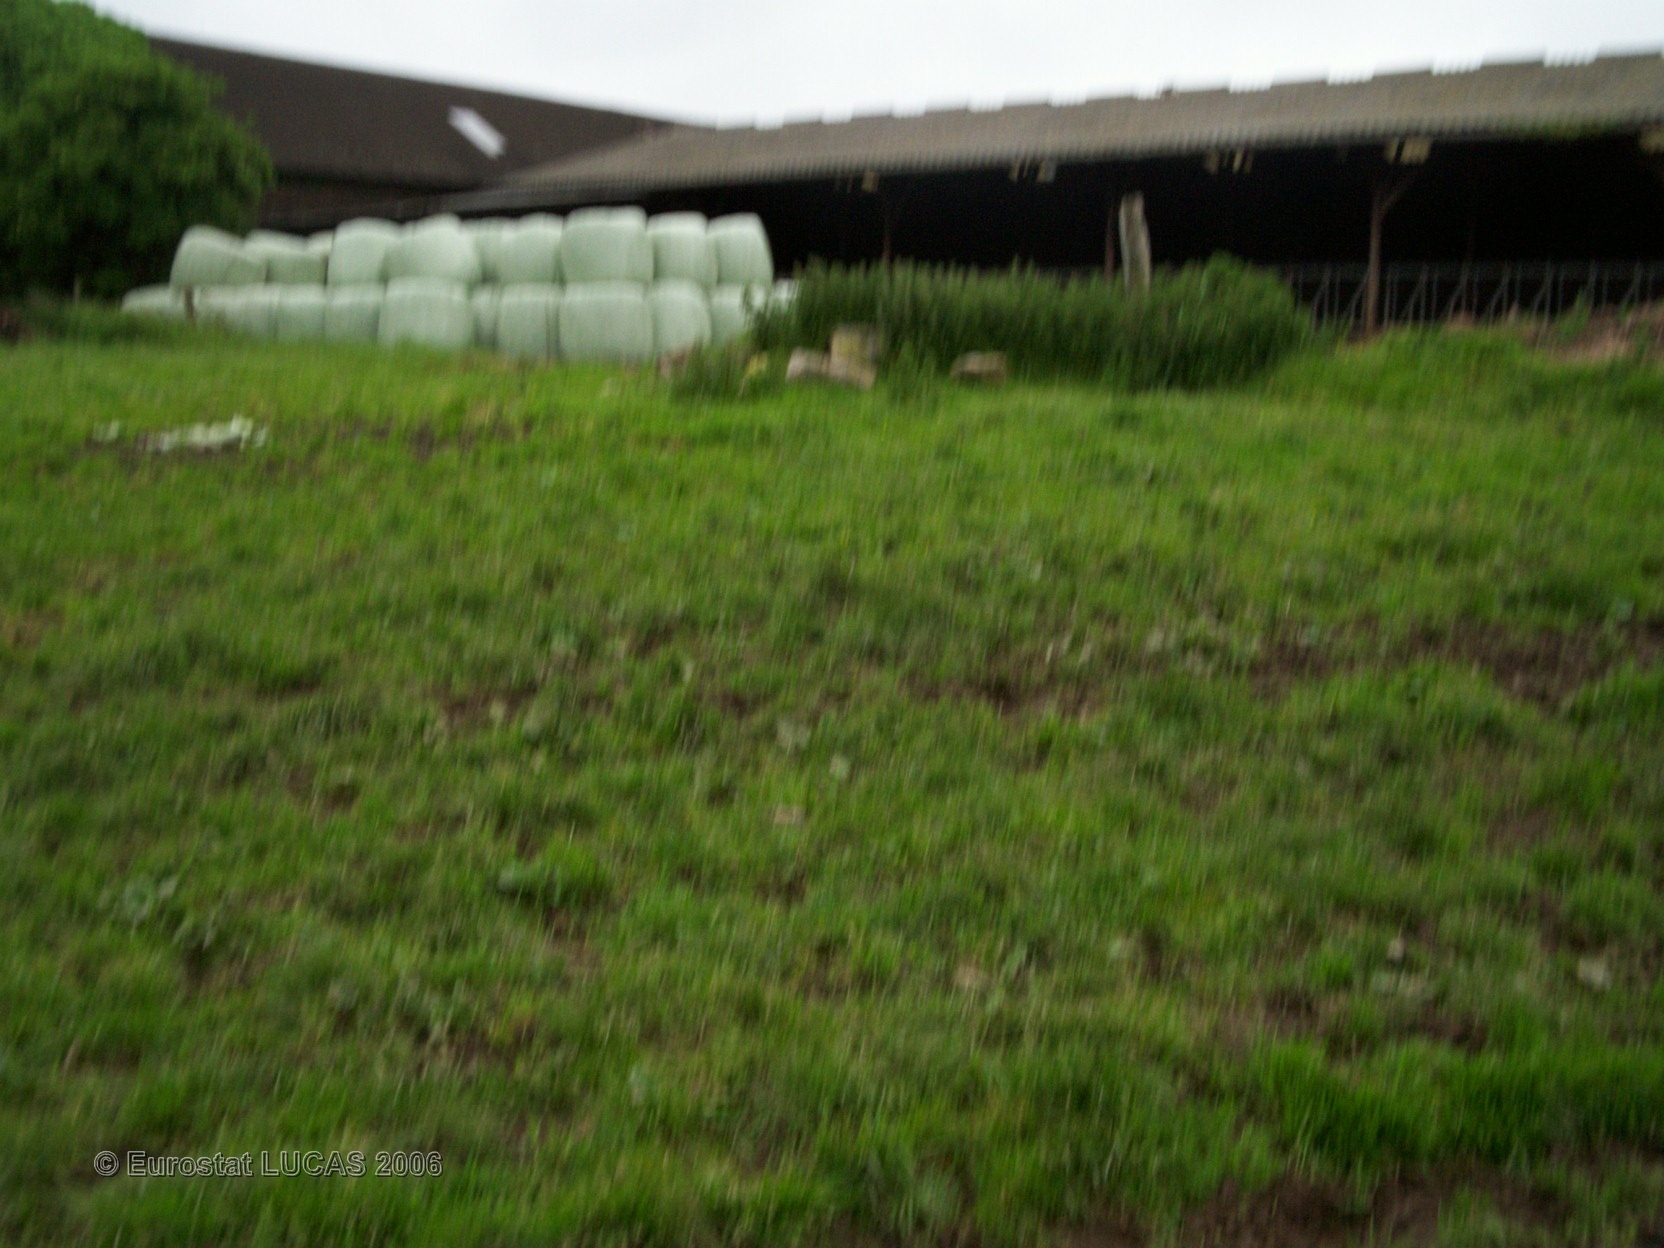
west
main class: Grassland
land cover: Grassland without tree/shrub cover
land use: Agriculture (excluding fallow land and kitchen gardens)
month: May
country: FR
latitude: 49.5982
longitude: 0.4119
